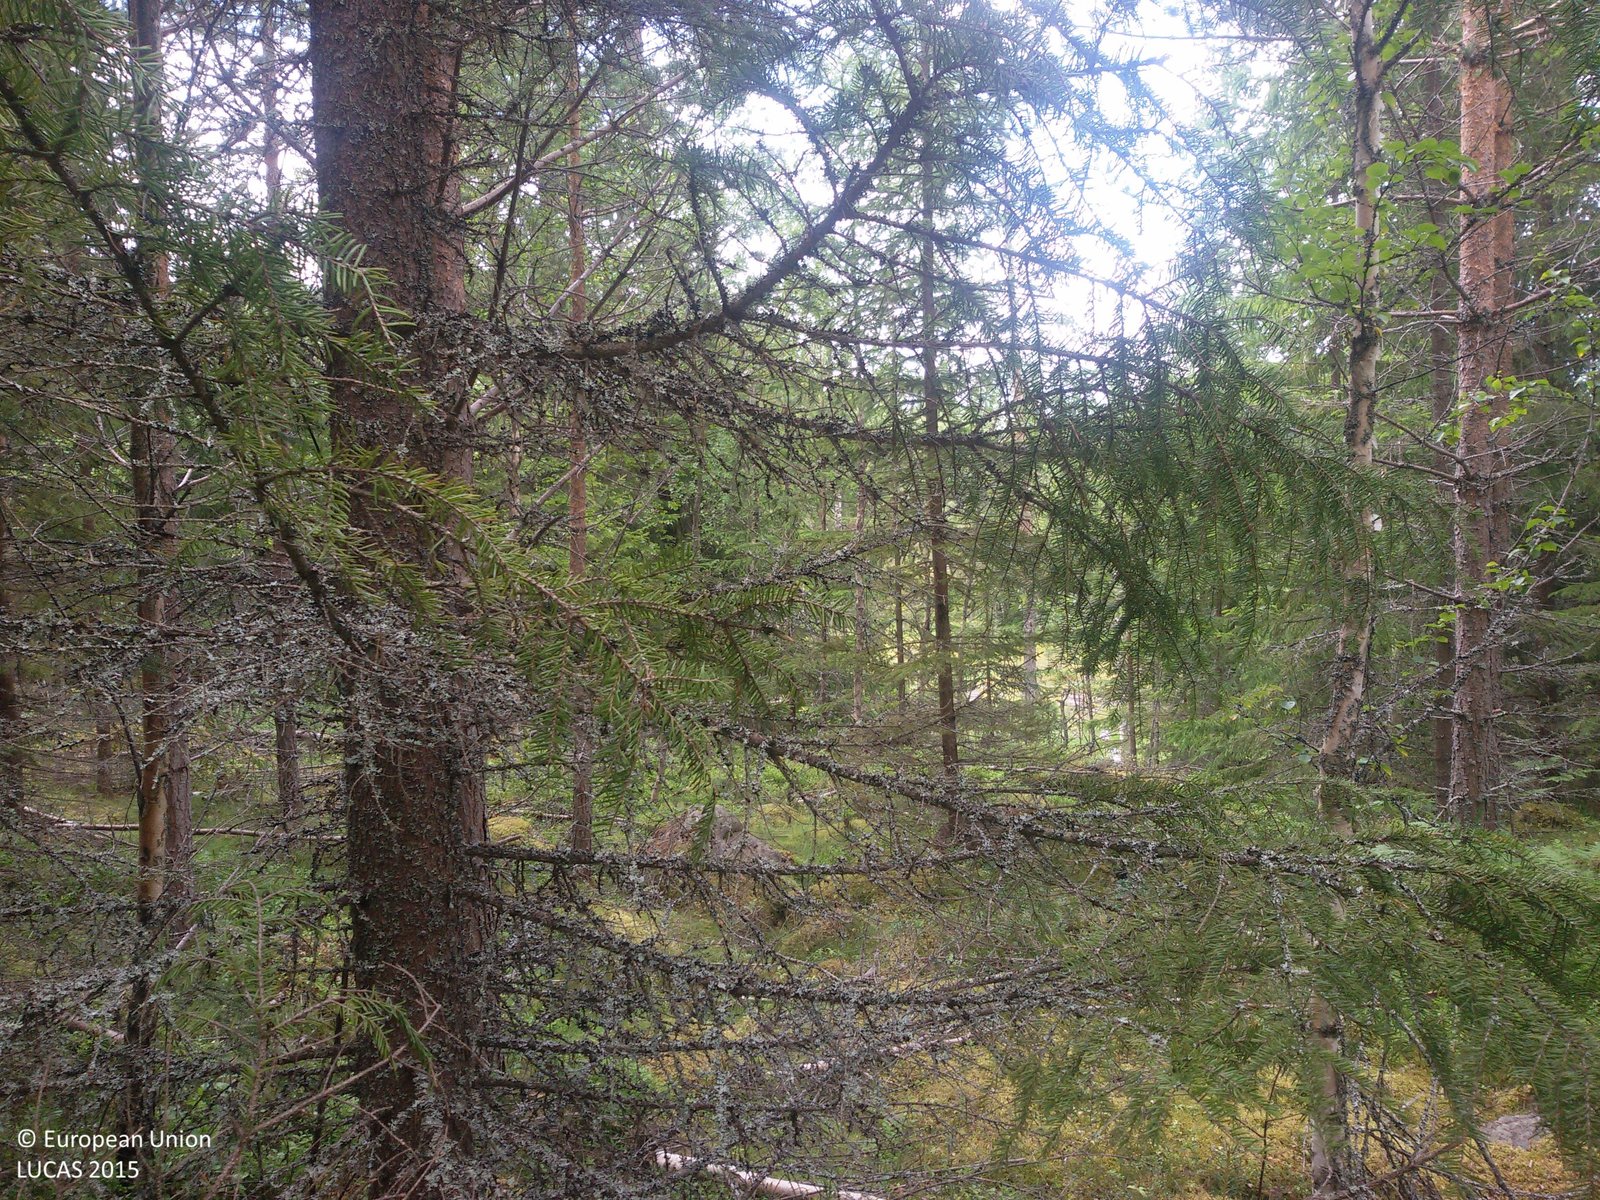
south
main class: Woodland
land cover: Spruce dominated mixed woodland
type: boreal forest
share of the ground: 50 - 75 %
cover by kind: coniferous forest trees 40 %, broadleaved forest trees 35 %, herbaceous plants 15 %, lichens and mosses 10 %
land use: Forestry
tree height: > 5 m
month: July
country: SE
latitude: 60.5506
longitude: 15.2936
